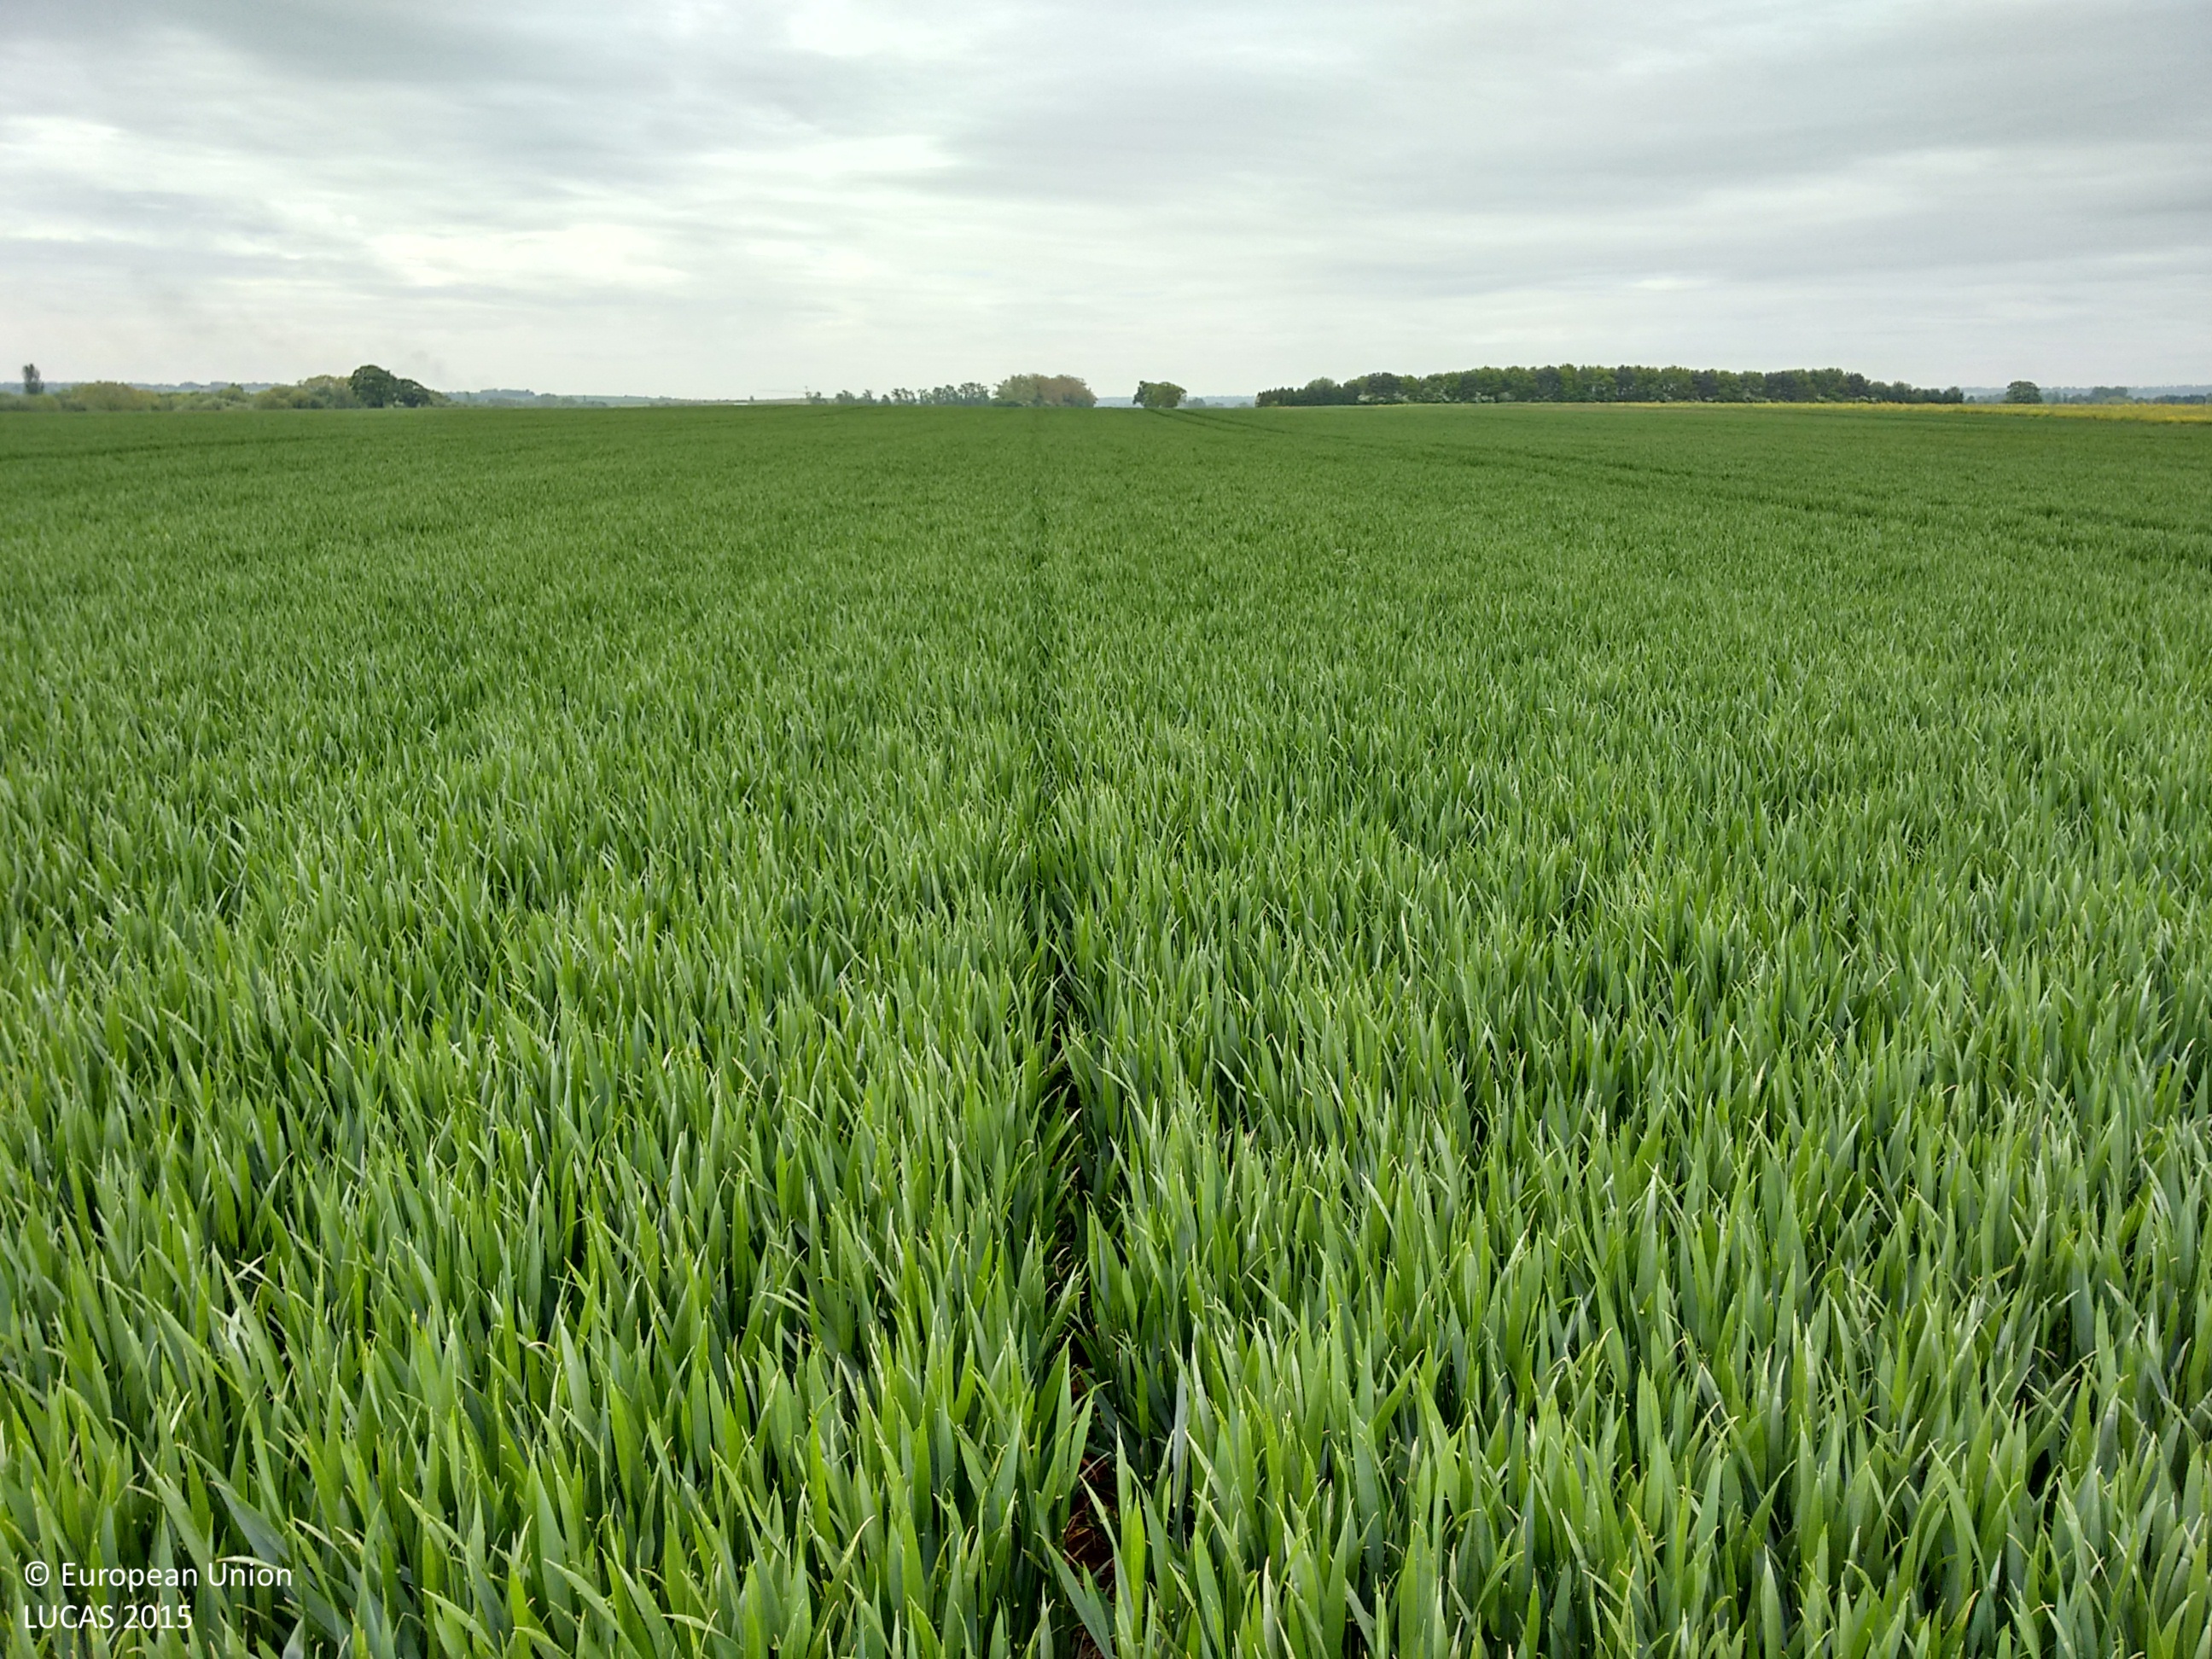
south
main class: Cropland
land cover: Barley
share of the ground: > 75 %
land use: Agriculture (excluding fallow land and kitchen gardens)
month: May
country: GB
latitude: 52.0206
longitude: -0.2803
